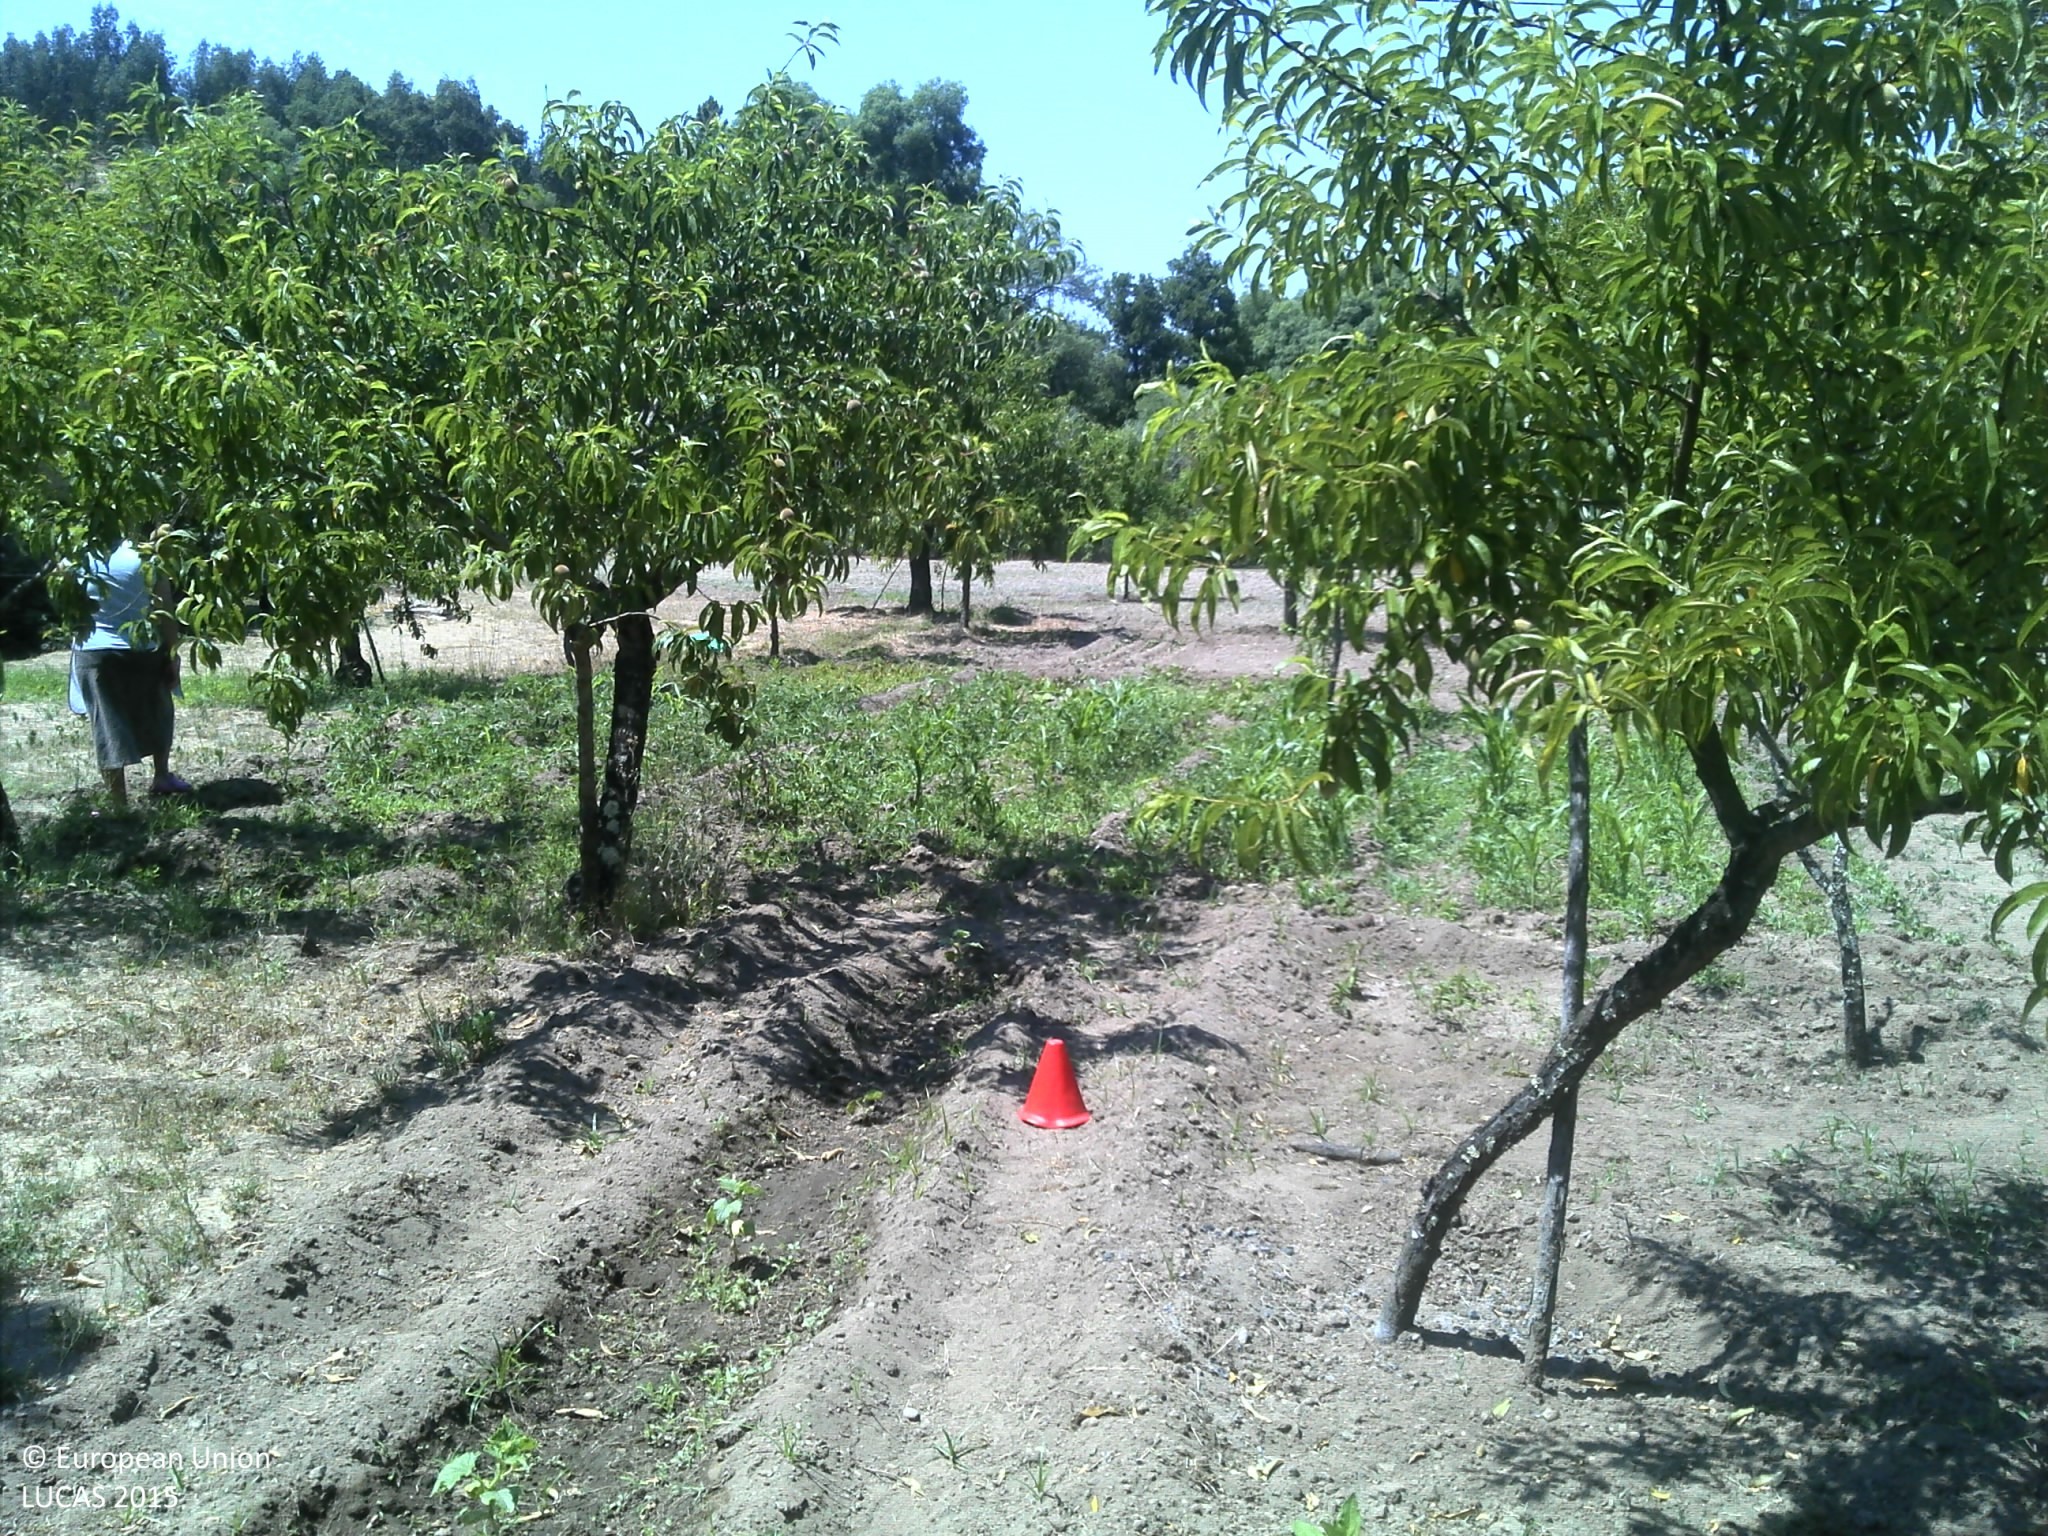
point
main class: Cropland
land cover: Other fruit trees and berries
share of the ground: 25 - 50 %
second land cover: Olive groves
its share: 25 - 50 %
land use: Agriculture (excluding fallow land and kitchen gardens)
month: June
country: PT
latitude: 39.4489
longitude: -8.0360
